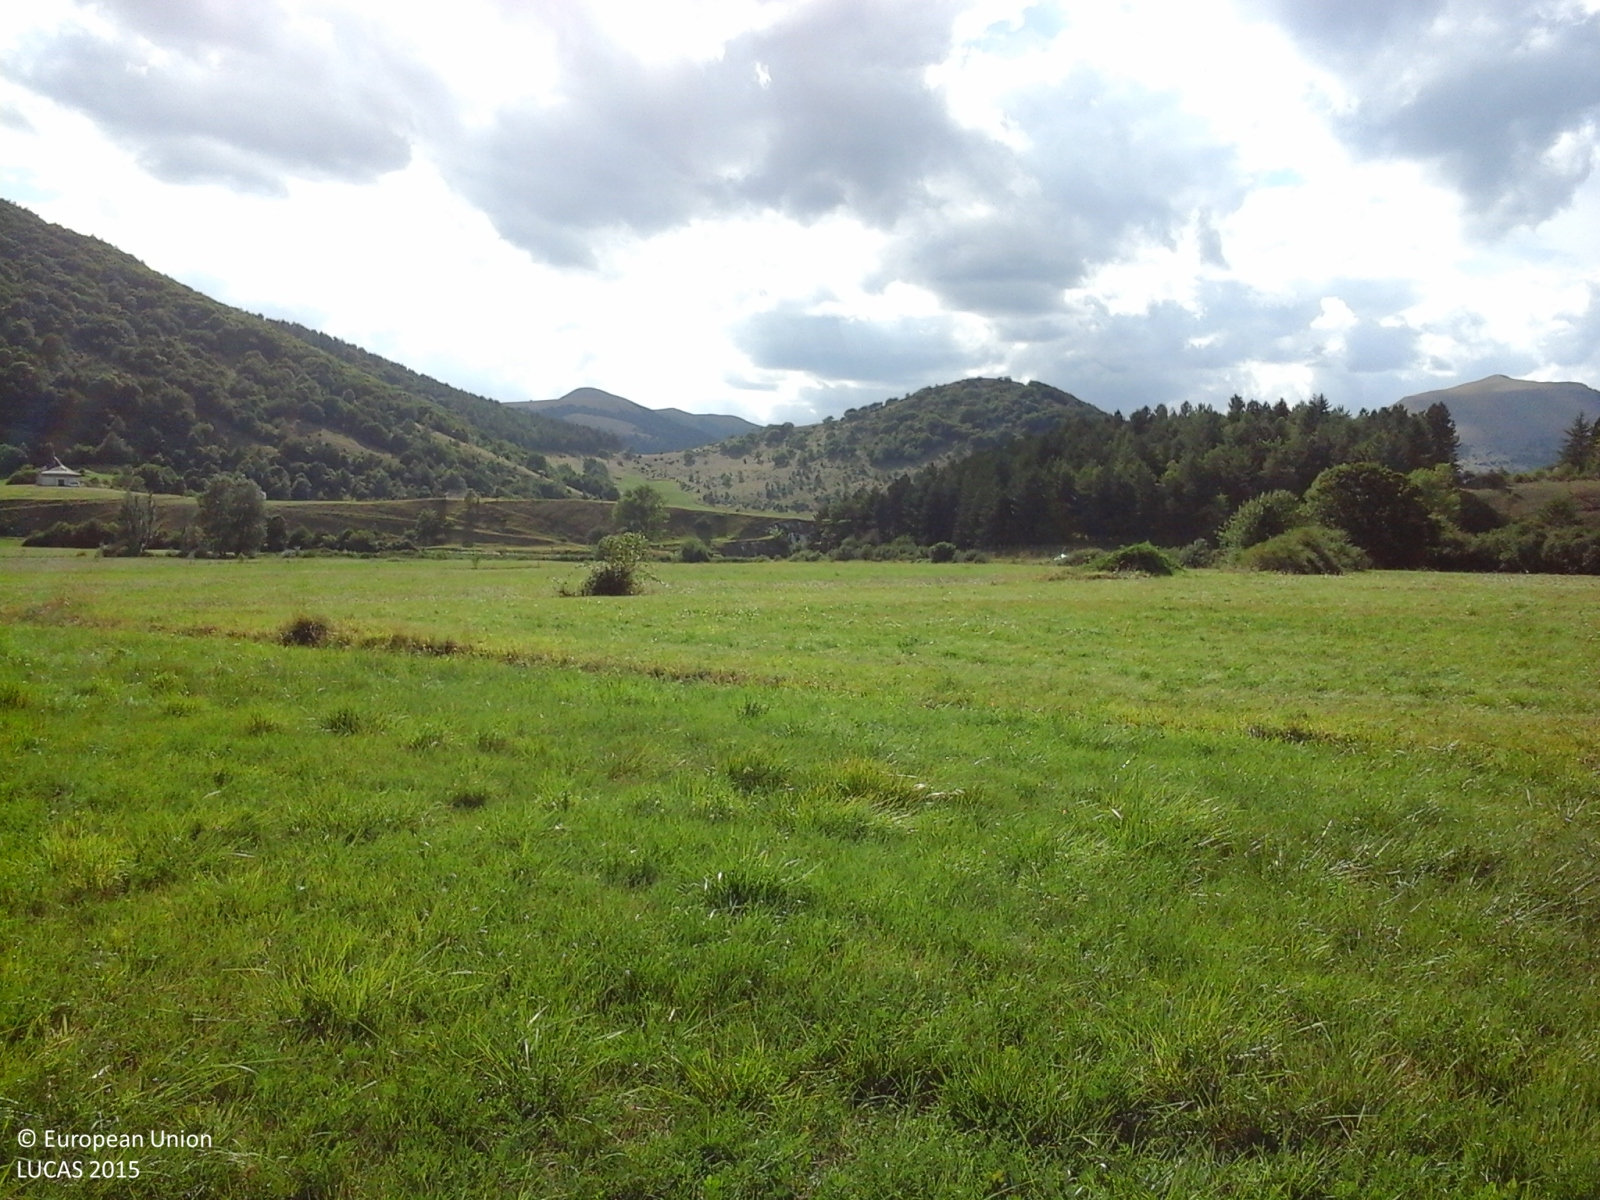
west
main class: Cropland
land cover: Temporary grasslands
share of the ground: > 75 %
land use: Agriculture (excluding fallow land and kitchen gardens)
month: August
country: IT
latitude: 43.1162
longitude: 12.9781
